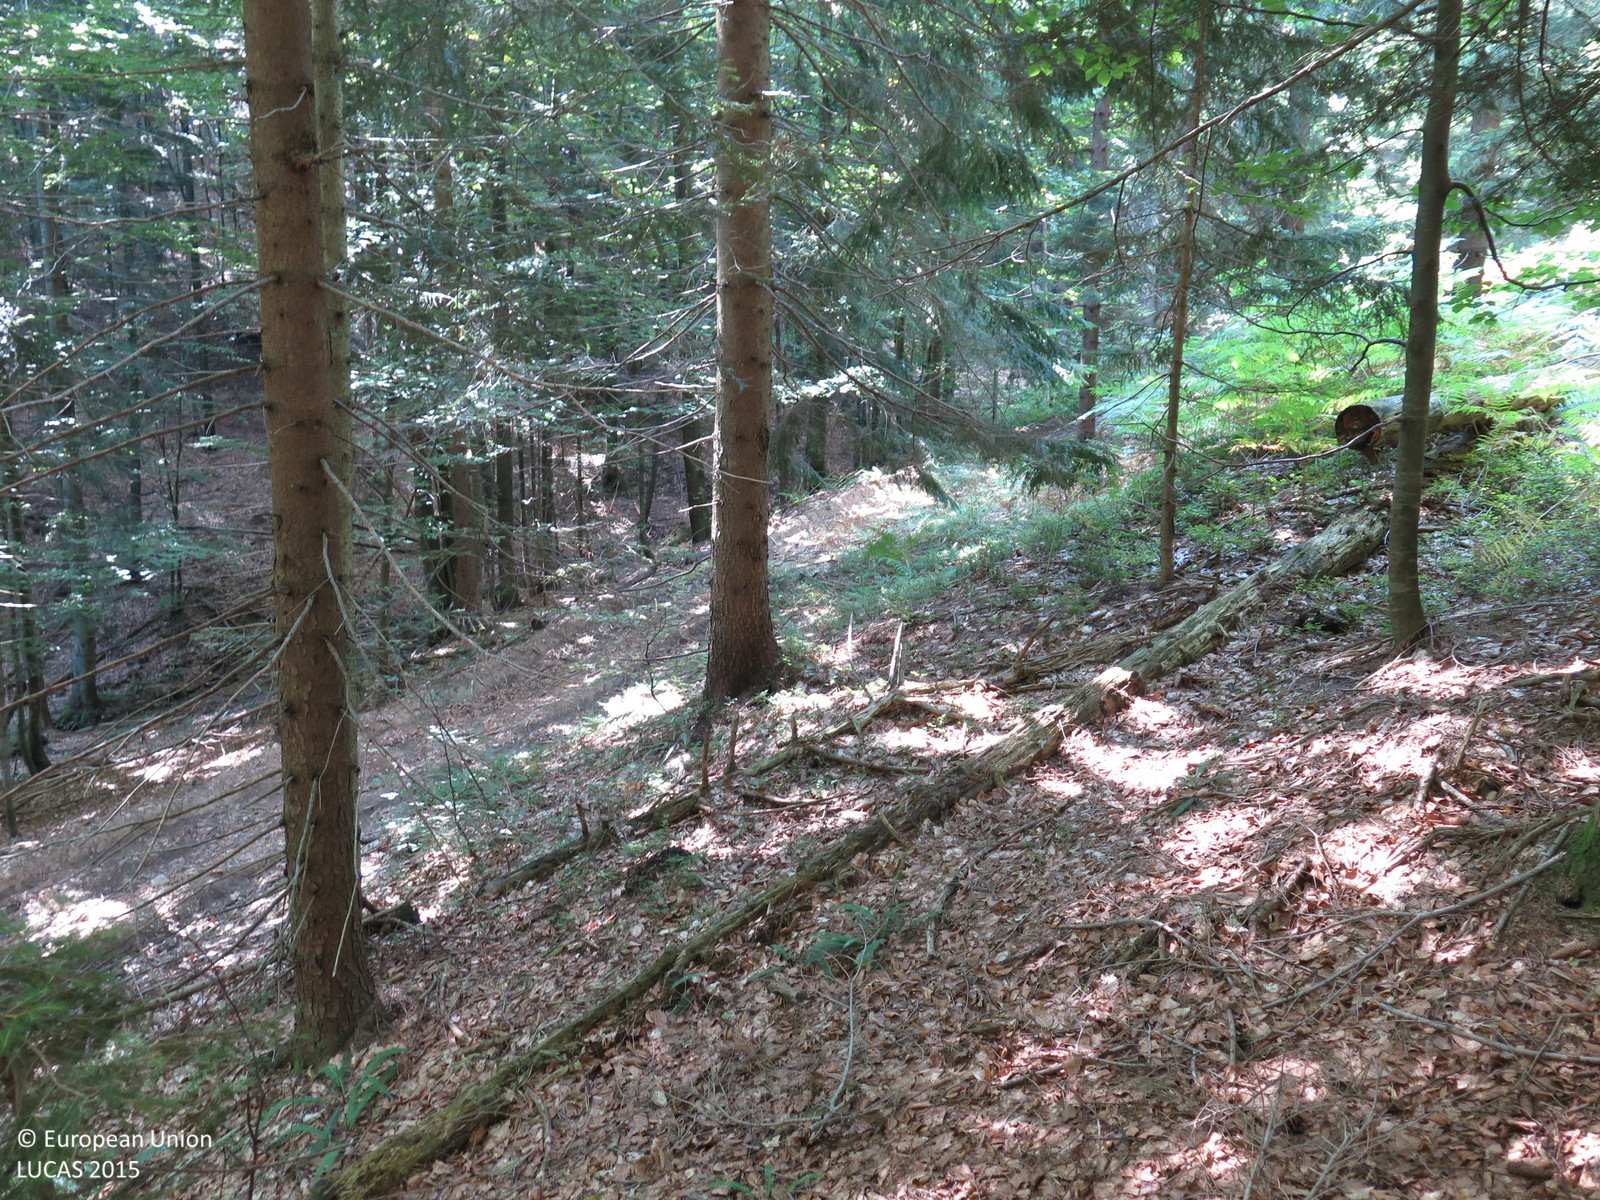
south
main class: Woodland
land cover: Other mixed woodland
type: beech forest
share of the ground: > 75 %
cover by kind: broadleaved forest trees 75 %, coniferous forest trees 25 %
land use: Forestry
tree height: > 5 m
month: August
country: HR
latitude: 45.3877
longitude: 14.9638
